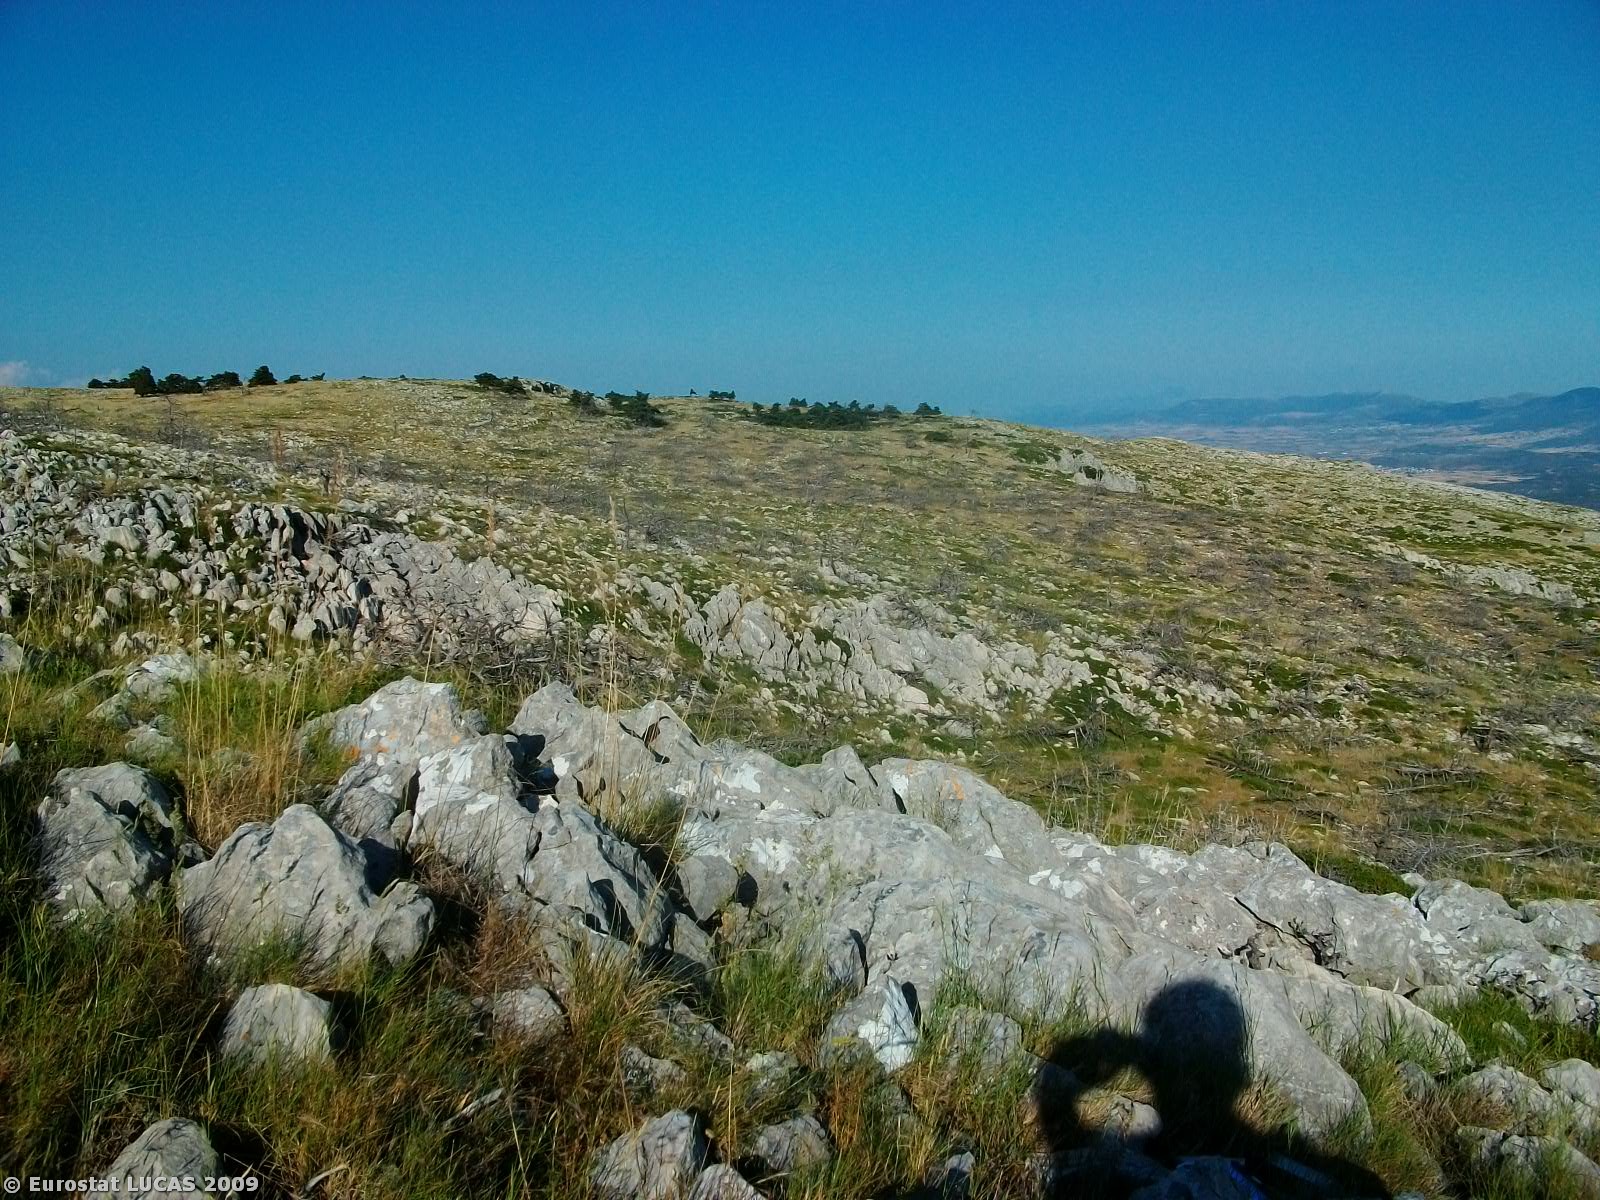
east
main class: Shrubland
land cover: Shrubland without tree cover
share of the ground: 50 - 75 %
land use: Agriculture (excluding fallow land and kitchen gardens)
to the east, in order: Shrubland without tree cover; Grassland without tree/shrub cover; Shrubland without tree cover
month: June
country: GR
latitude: 38.2931
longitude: 23.0468
